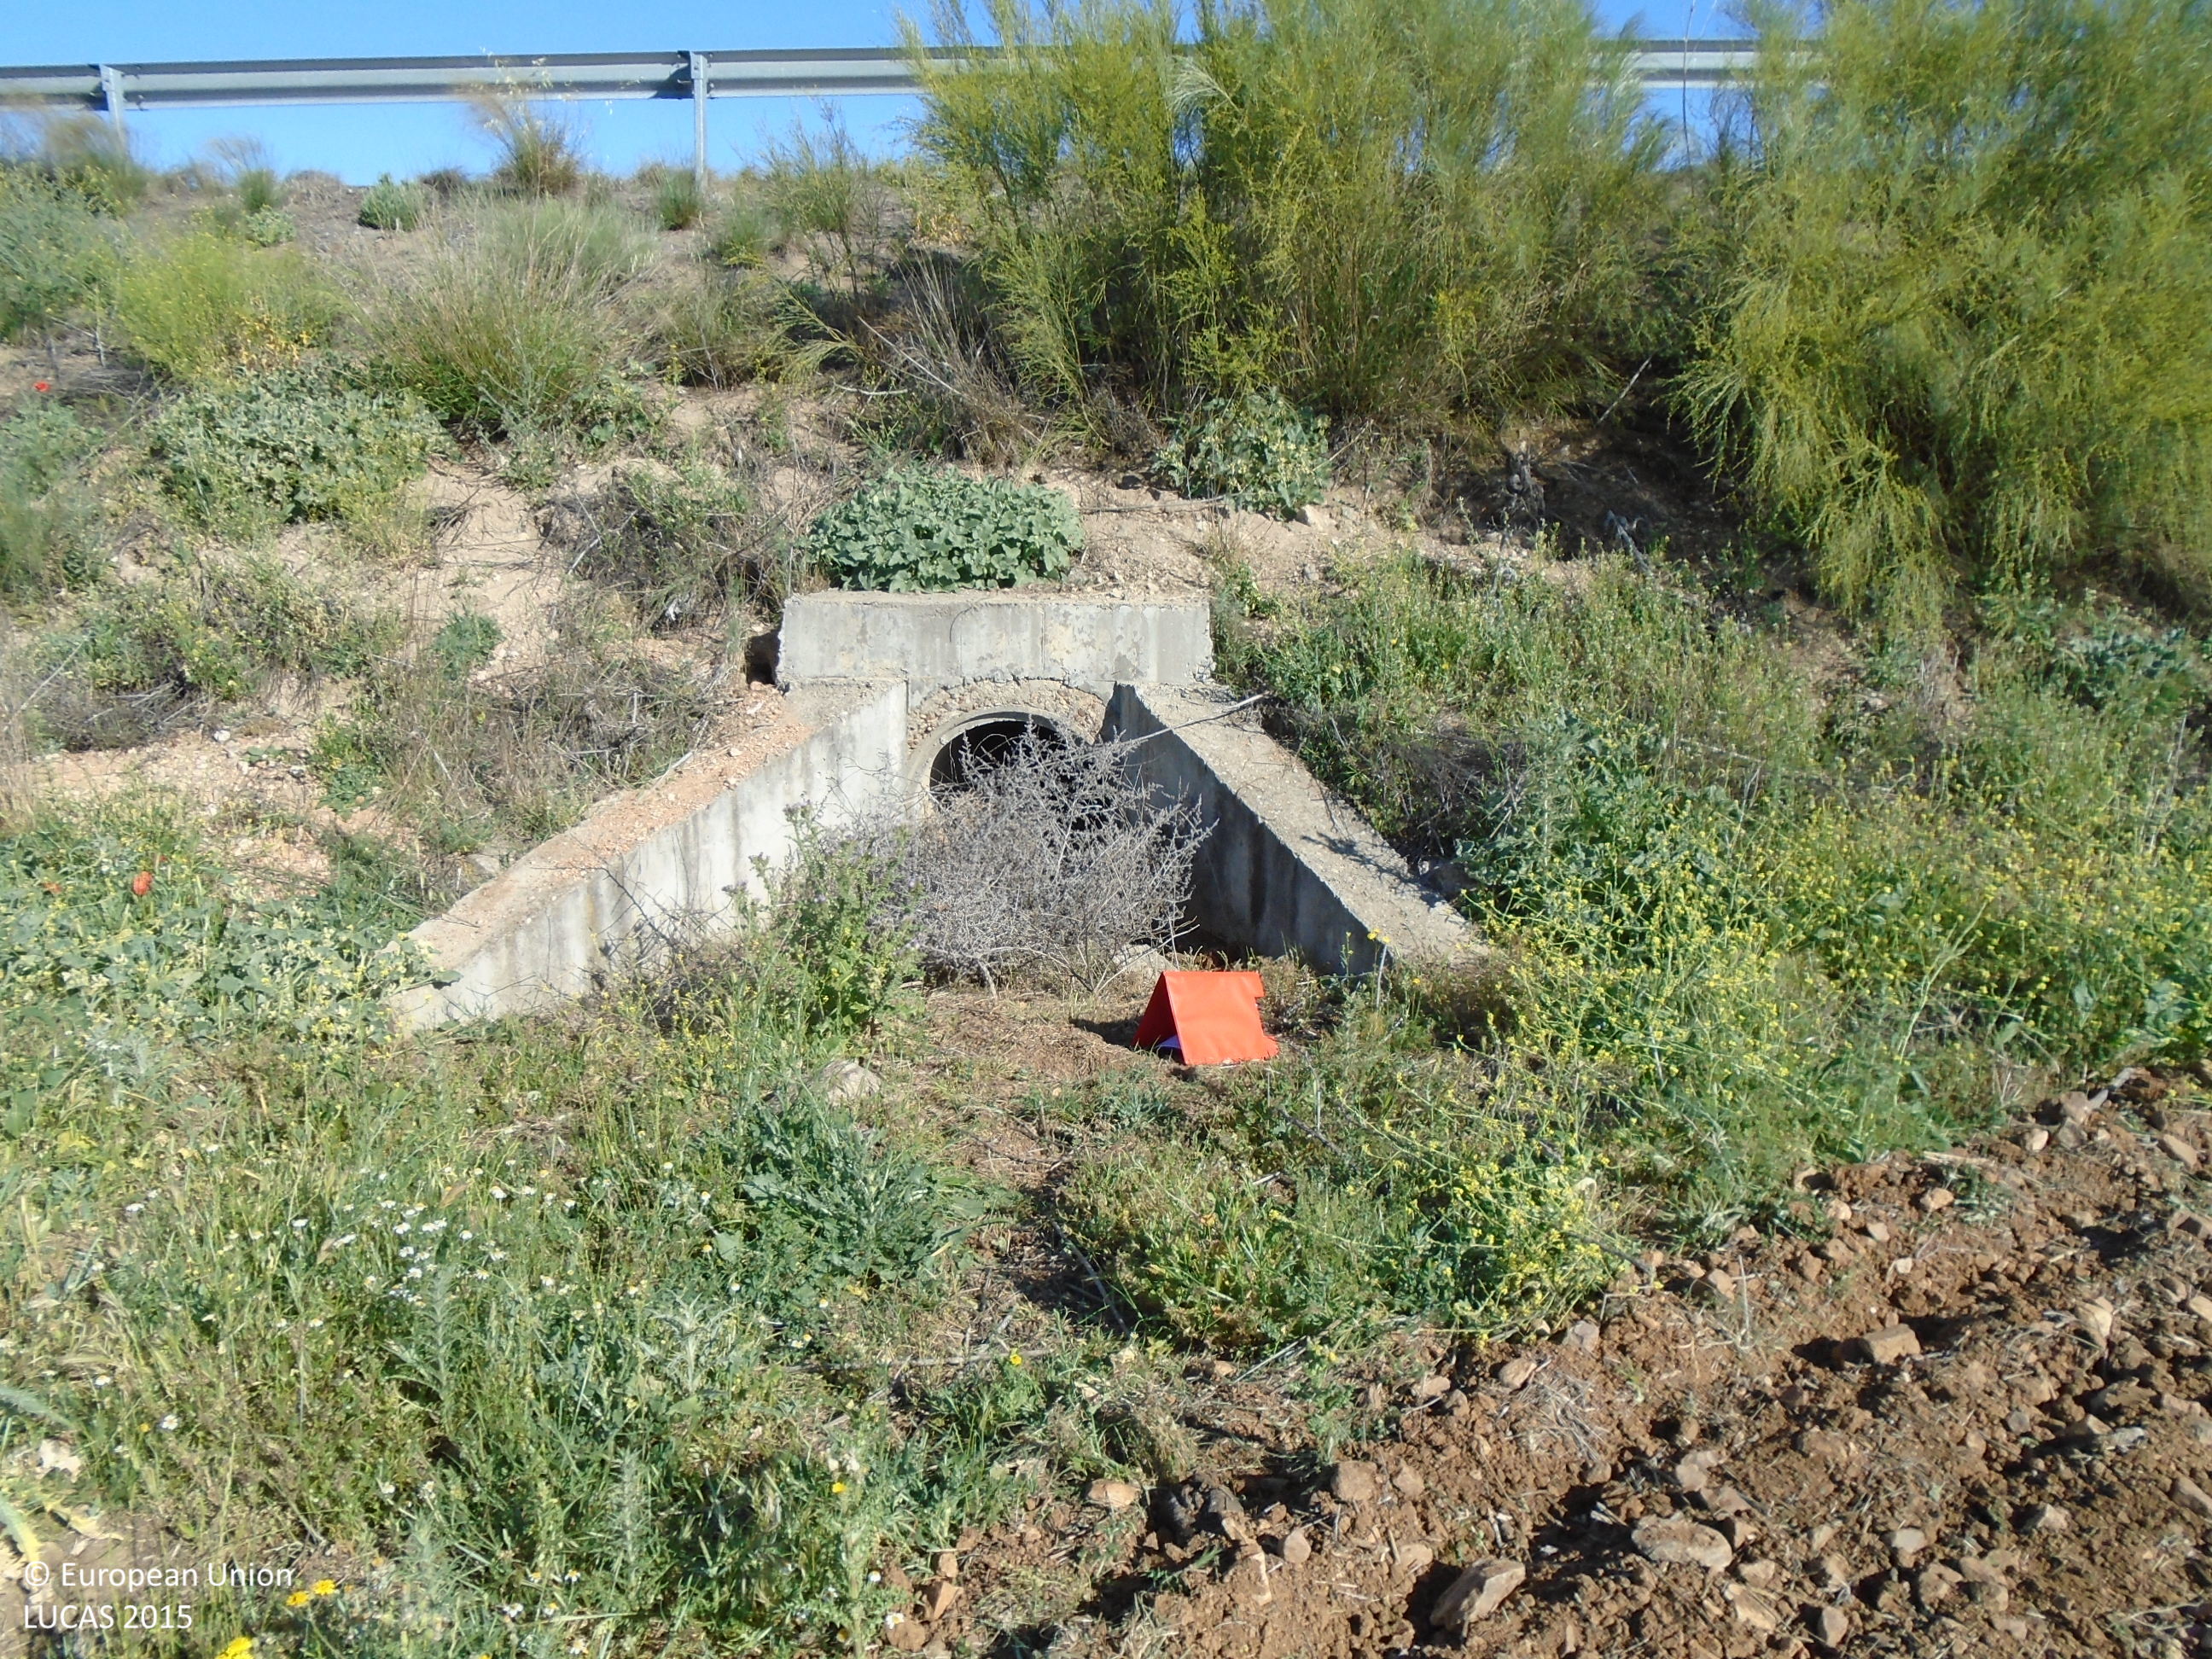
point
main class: Grassland
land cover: Spontaneously vegetated surfaces
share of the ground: > 75 %
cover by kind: herbaceous plants 95 %, consolidated bare surface 5 %
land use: Semi-natural and natural areas not in use
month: May
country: ES
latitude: 39.7177
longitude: -3.7354
